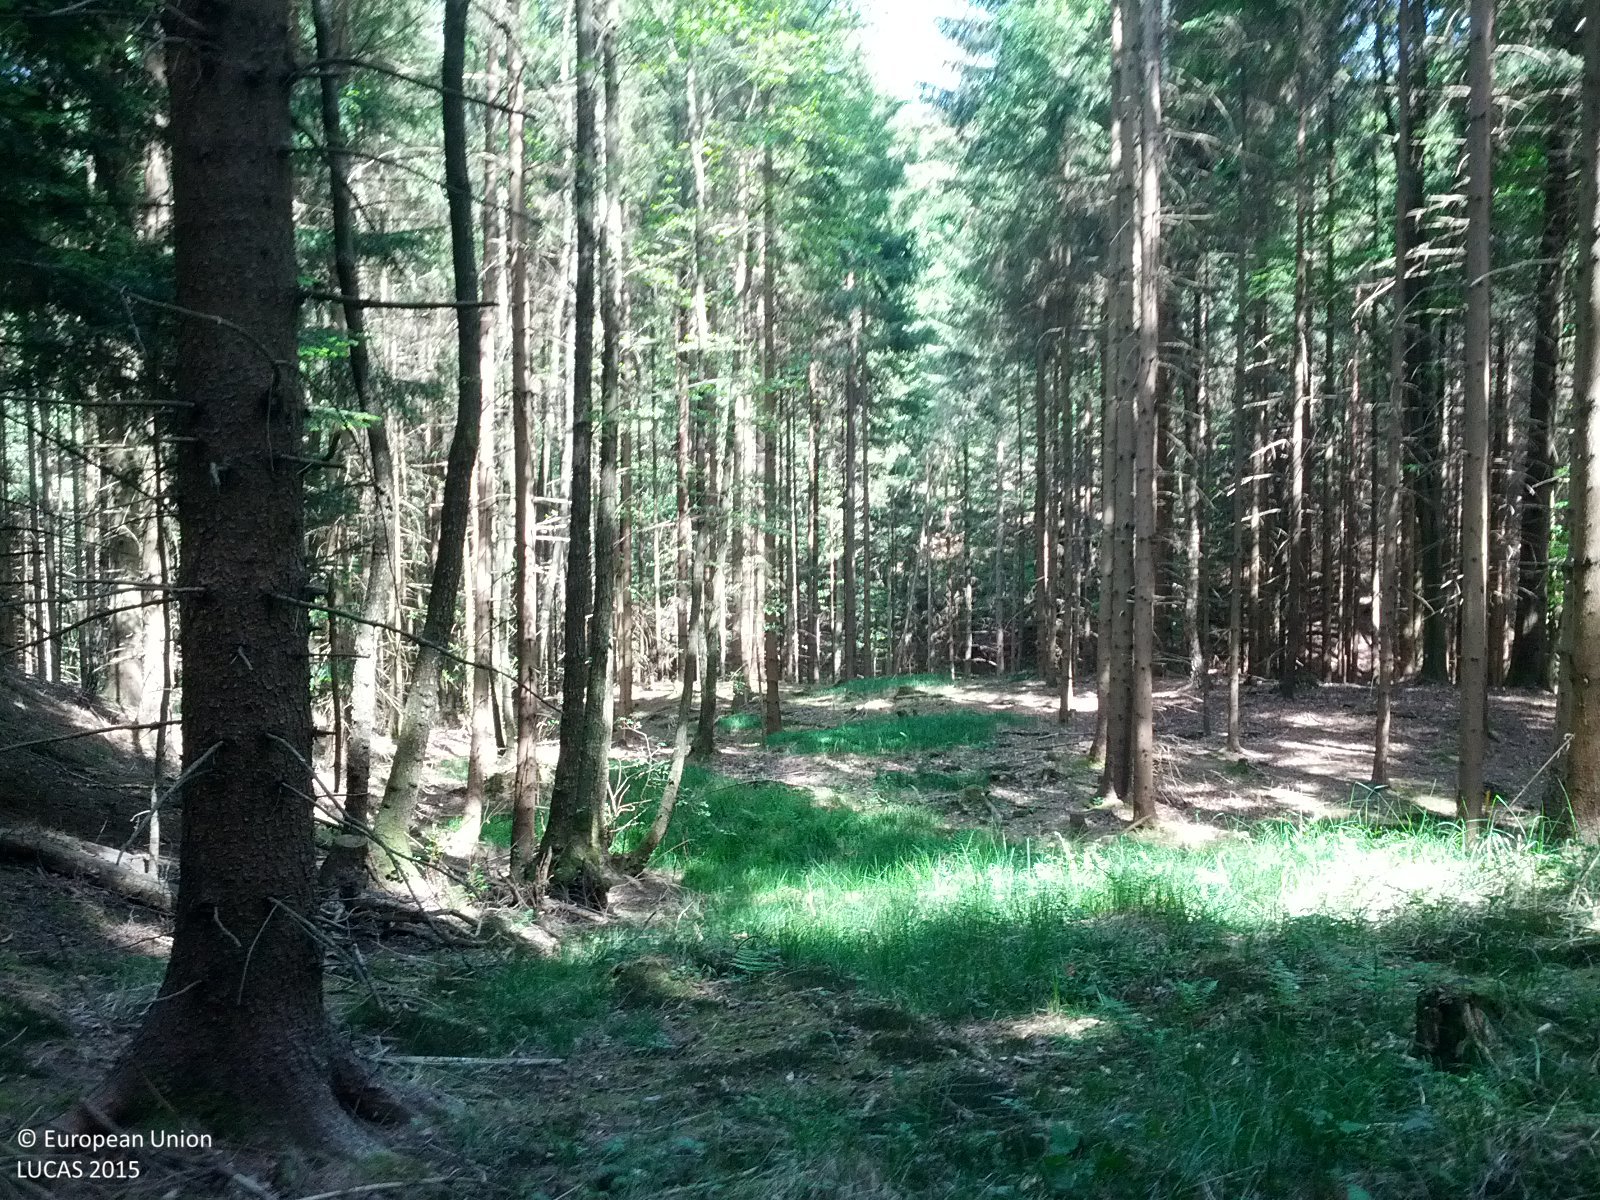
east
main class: Woodland
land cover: Spruce dominated coniferous woodland
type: boreal forest
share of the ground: > 75 %
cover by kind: coniferous forest trees 80 %, lichens and mosses 10 %, broadleaved forest trees 5 %, herbaceous plants 5 %
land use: Forestry
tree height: > 5 m
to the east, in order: Spruce dominated coniferous woodland; Rivers and streams; Spruce dominated coniferous woodland
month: May
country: AT
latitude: 47.4057
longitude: 16.0847
